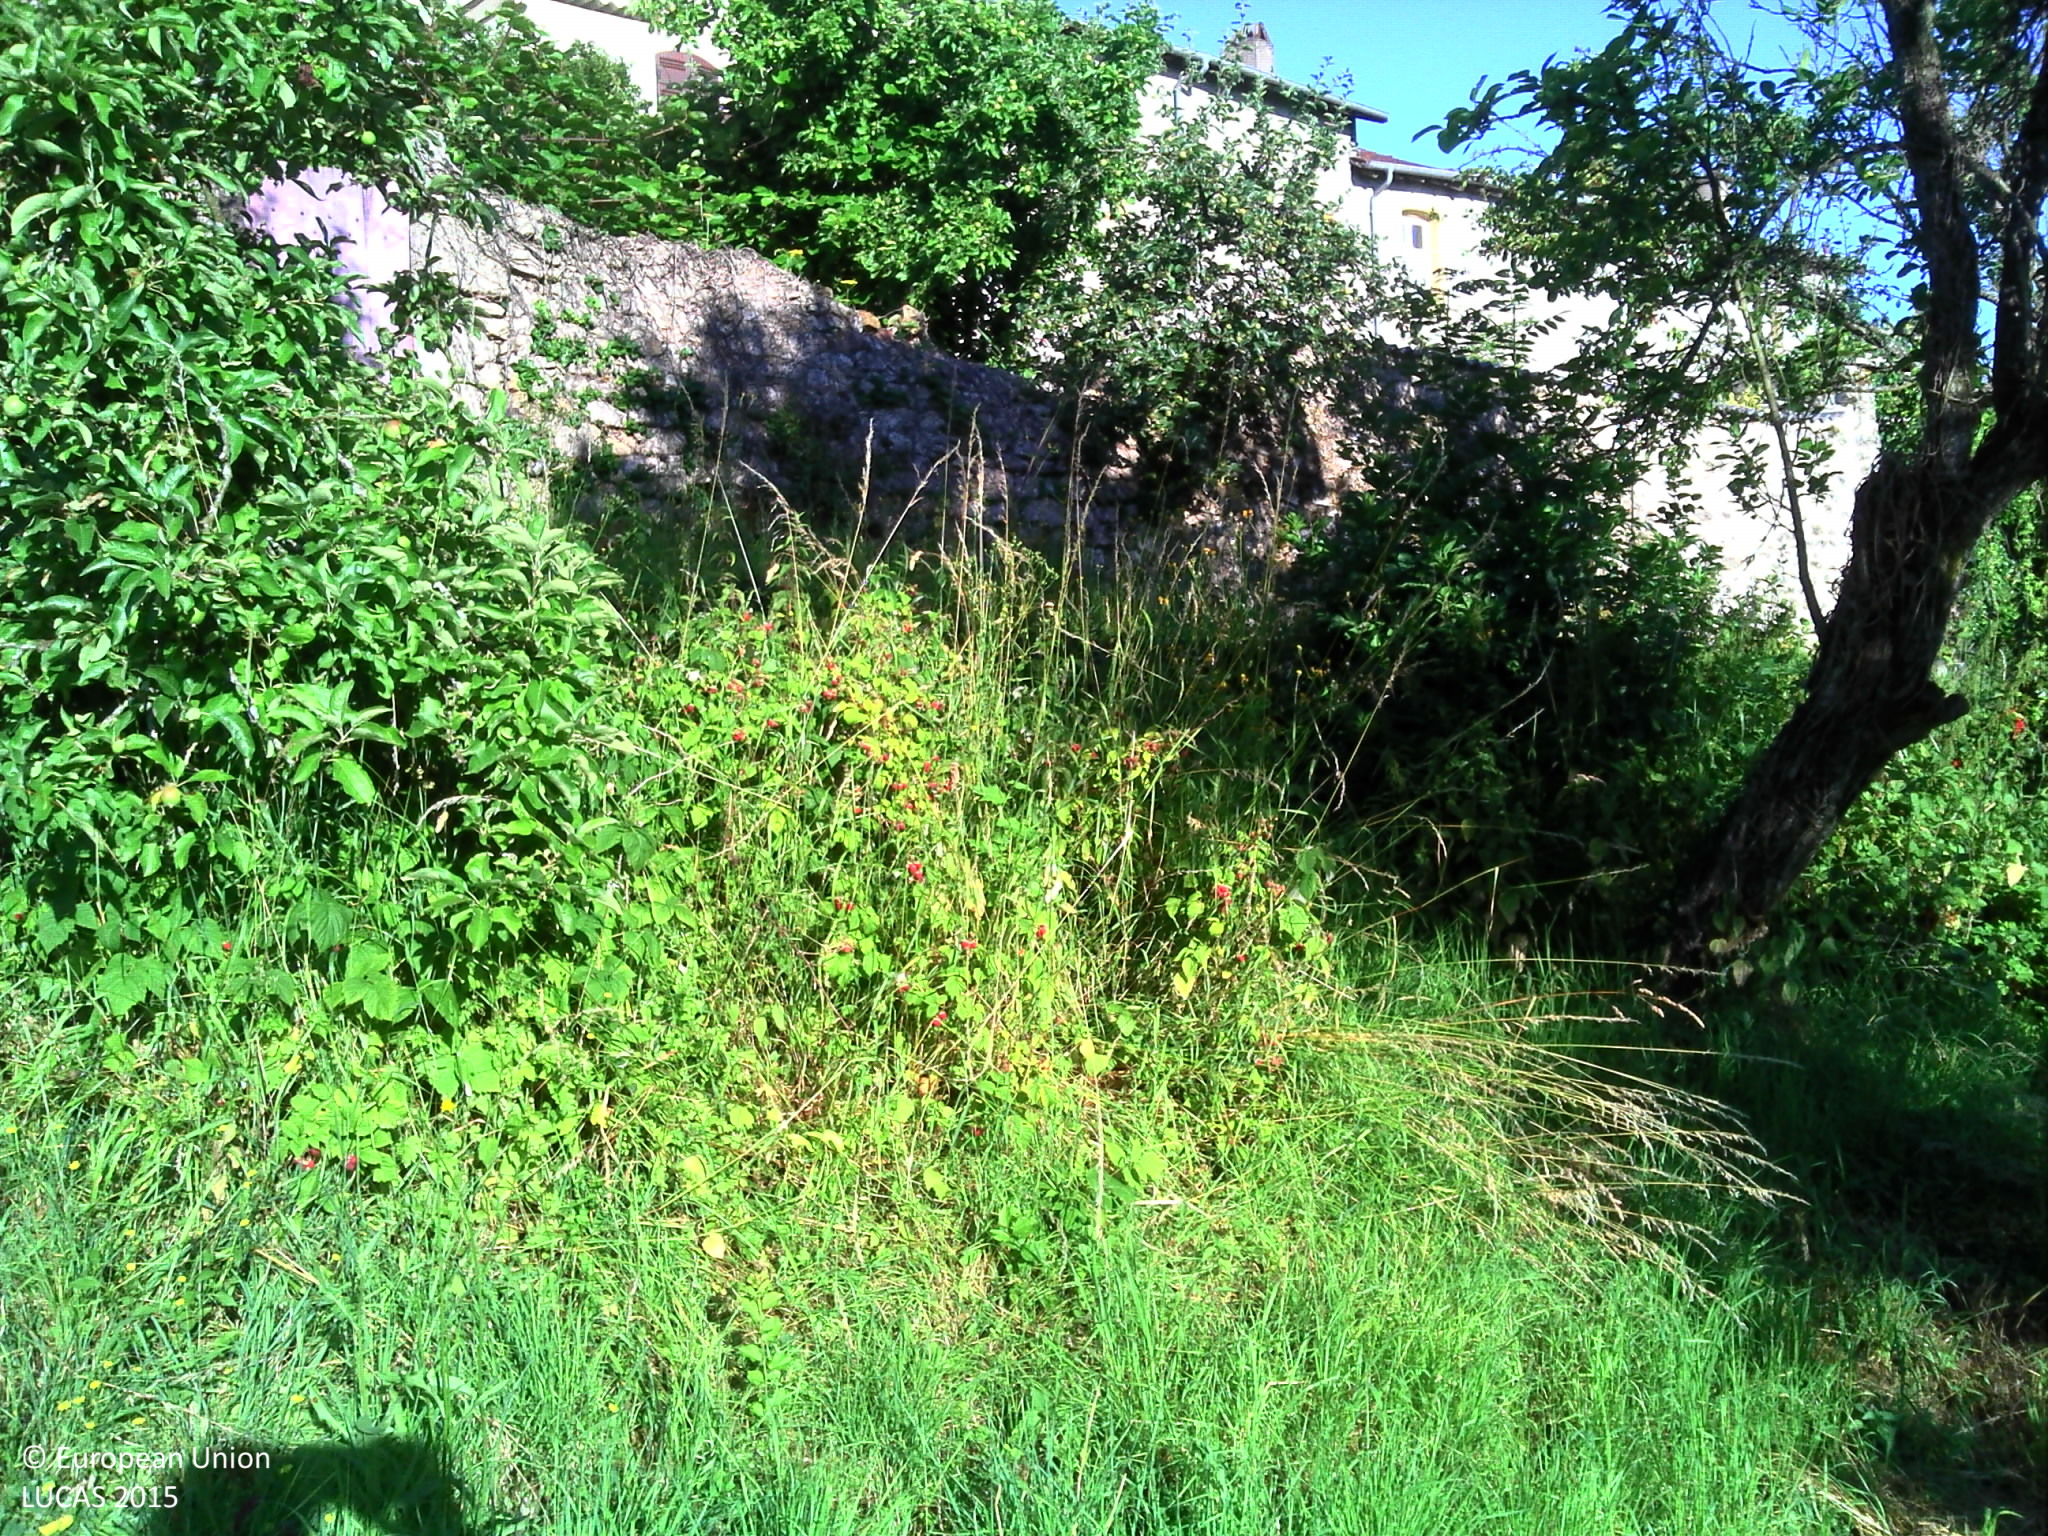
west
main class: Cropland
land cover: Cherry fruit
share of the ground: 50 - 75 %
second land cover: Other fruit trees and berries
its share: 50 - 75 %
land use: Kitchen garden
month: June
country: FR
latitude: 48.9795
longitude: 5.9963
